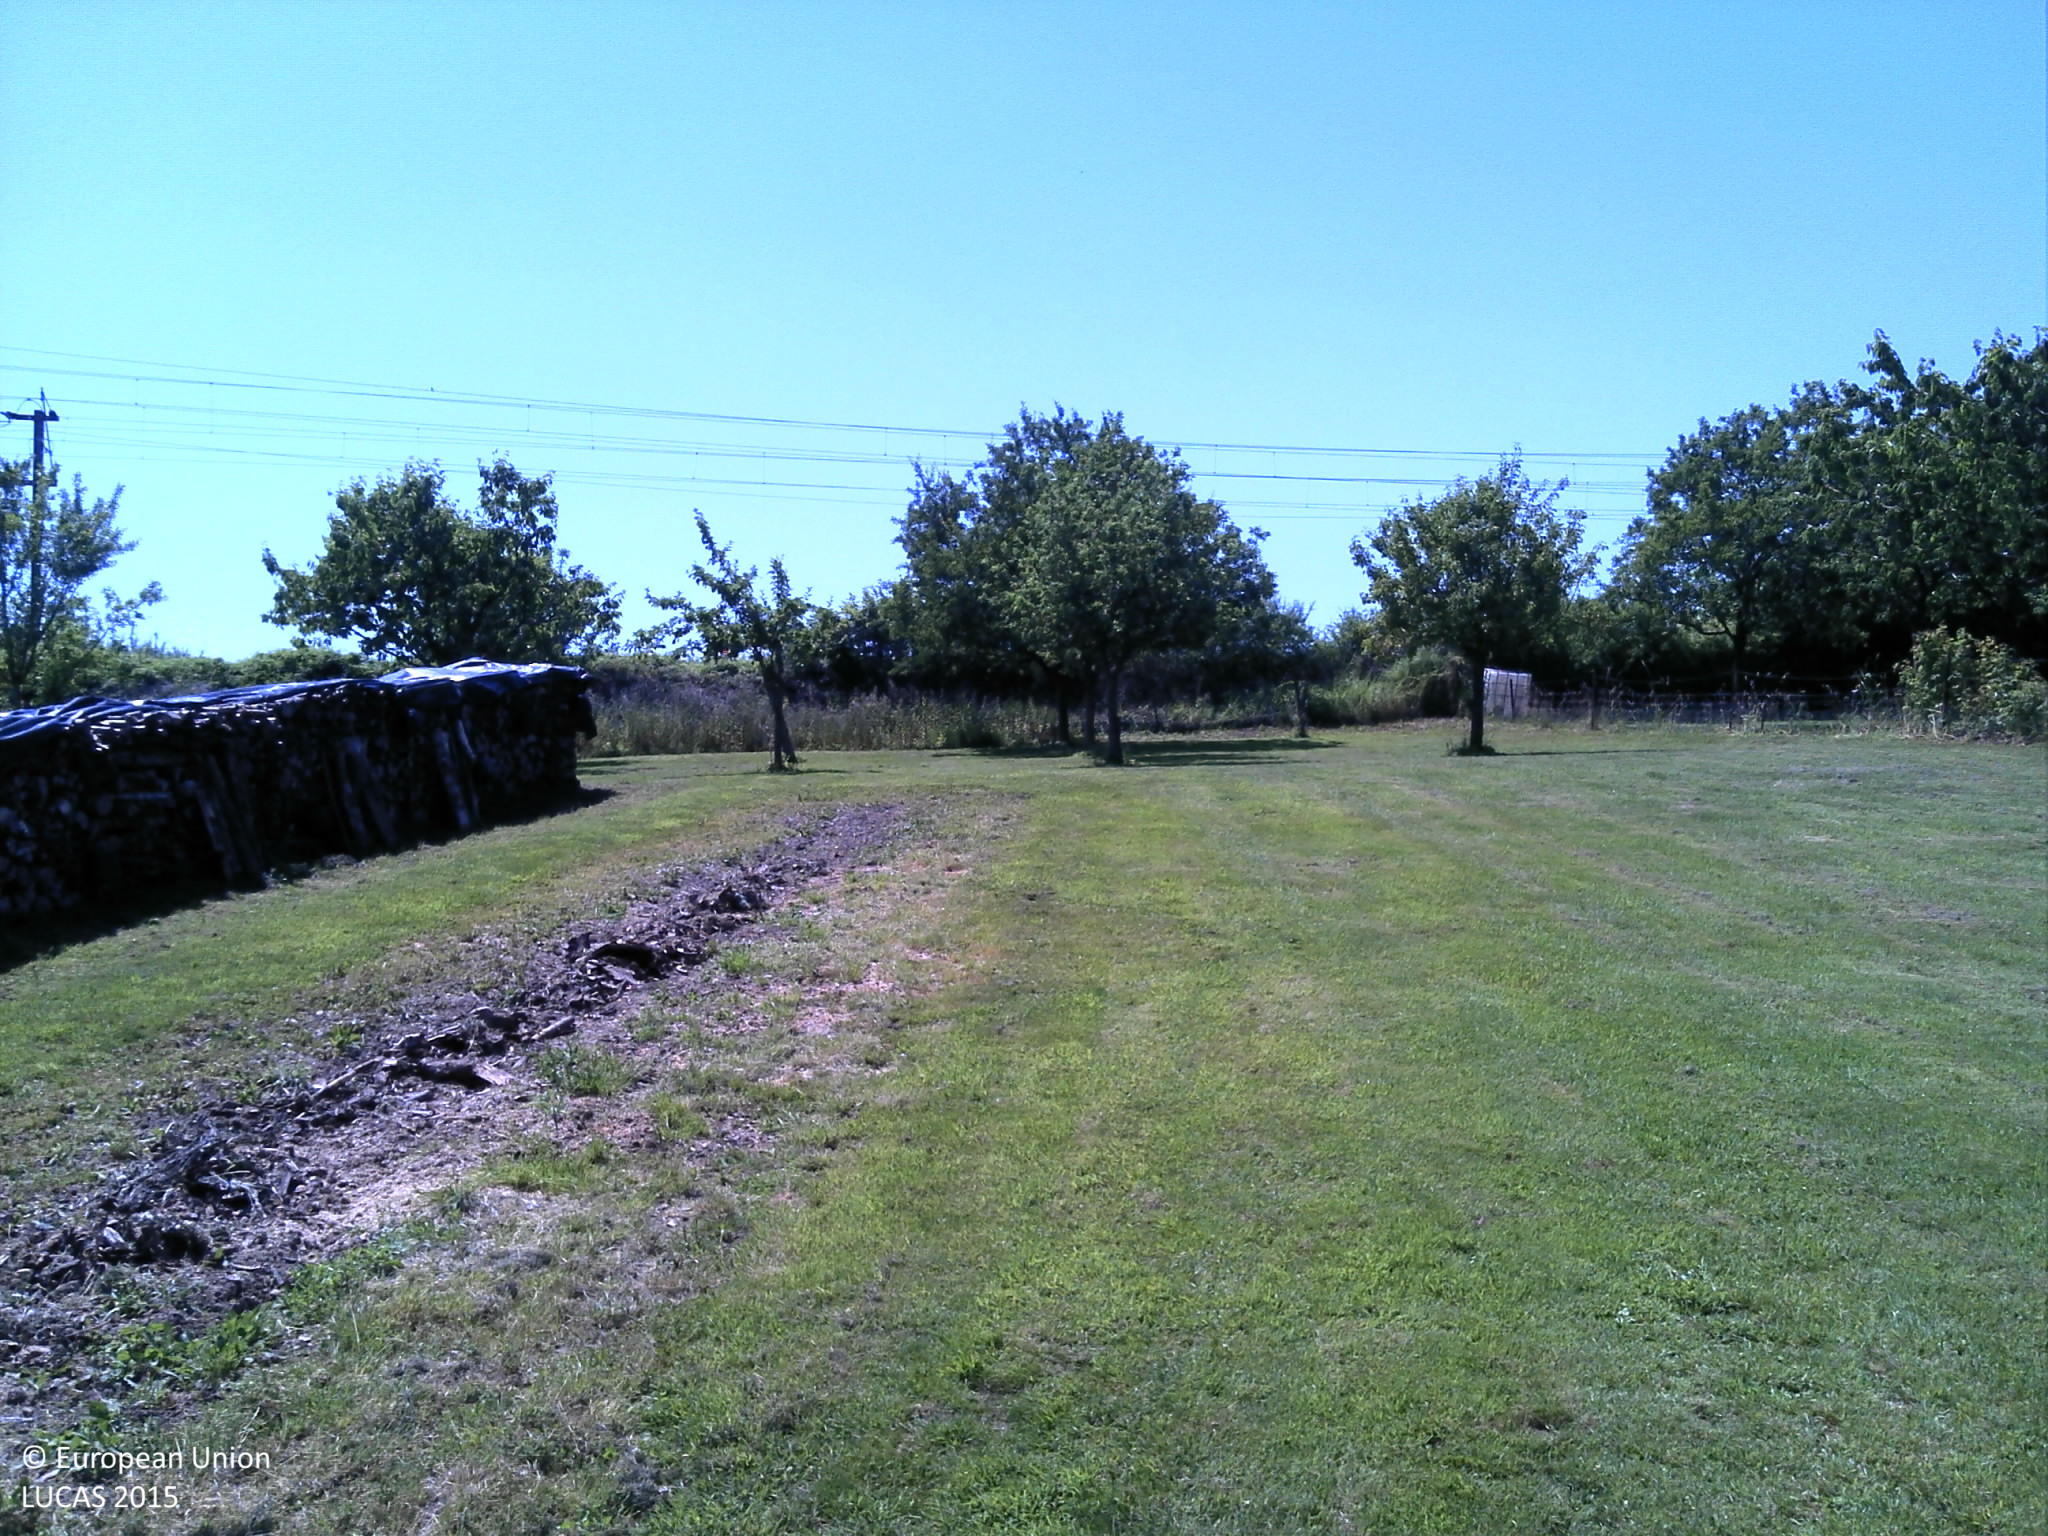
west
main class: Grassland
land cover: Grassland with sparse tree/shrub cover
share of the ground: > 75 %
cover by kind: herbaceous plants 95 %, coniferous forest trees 5 %
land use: Residential
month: July
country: FR
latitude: 49.8216
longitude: 4.2269
